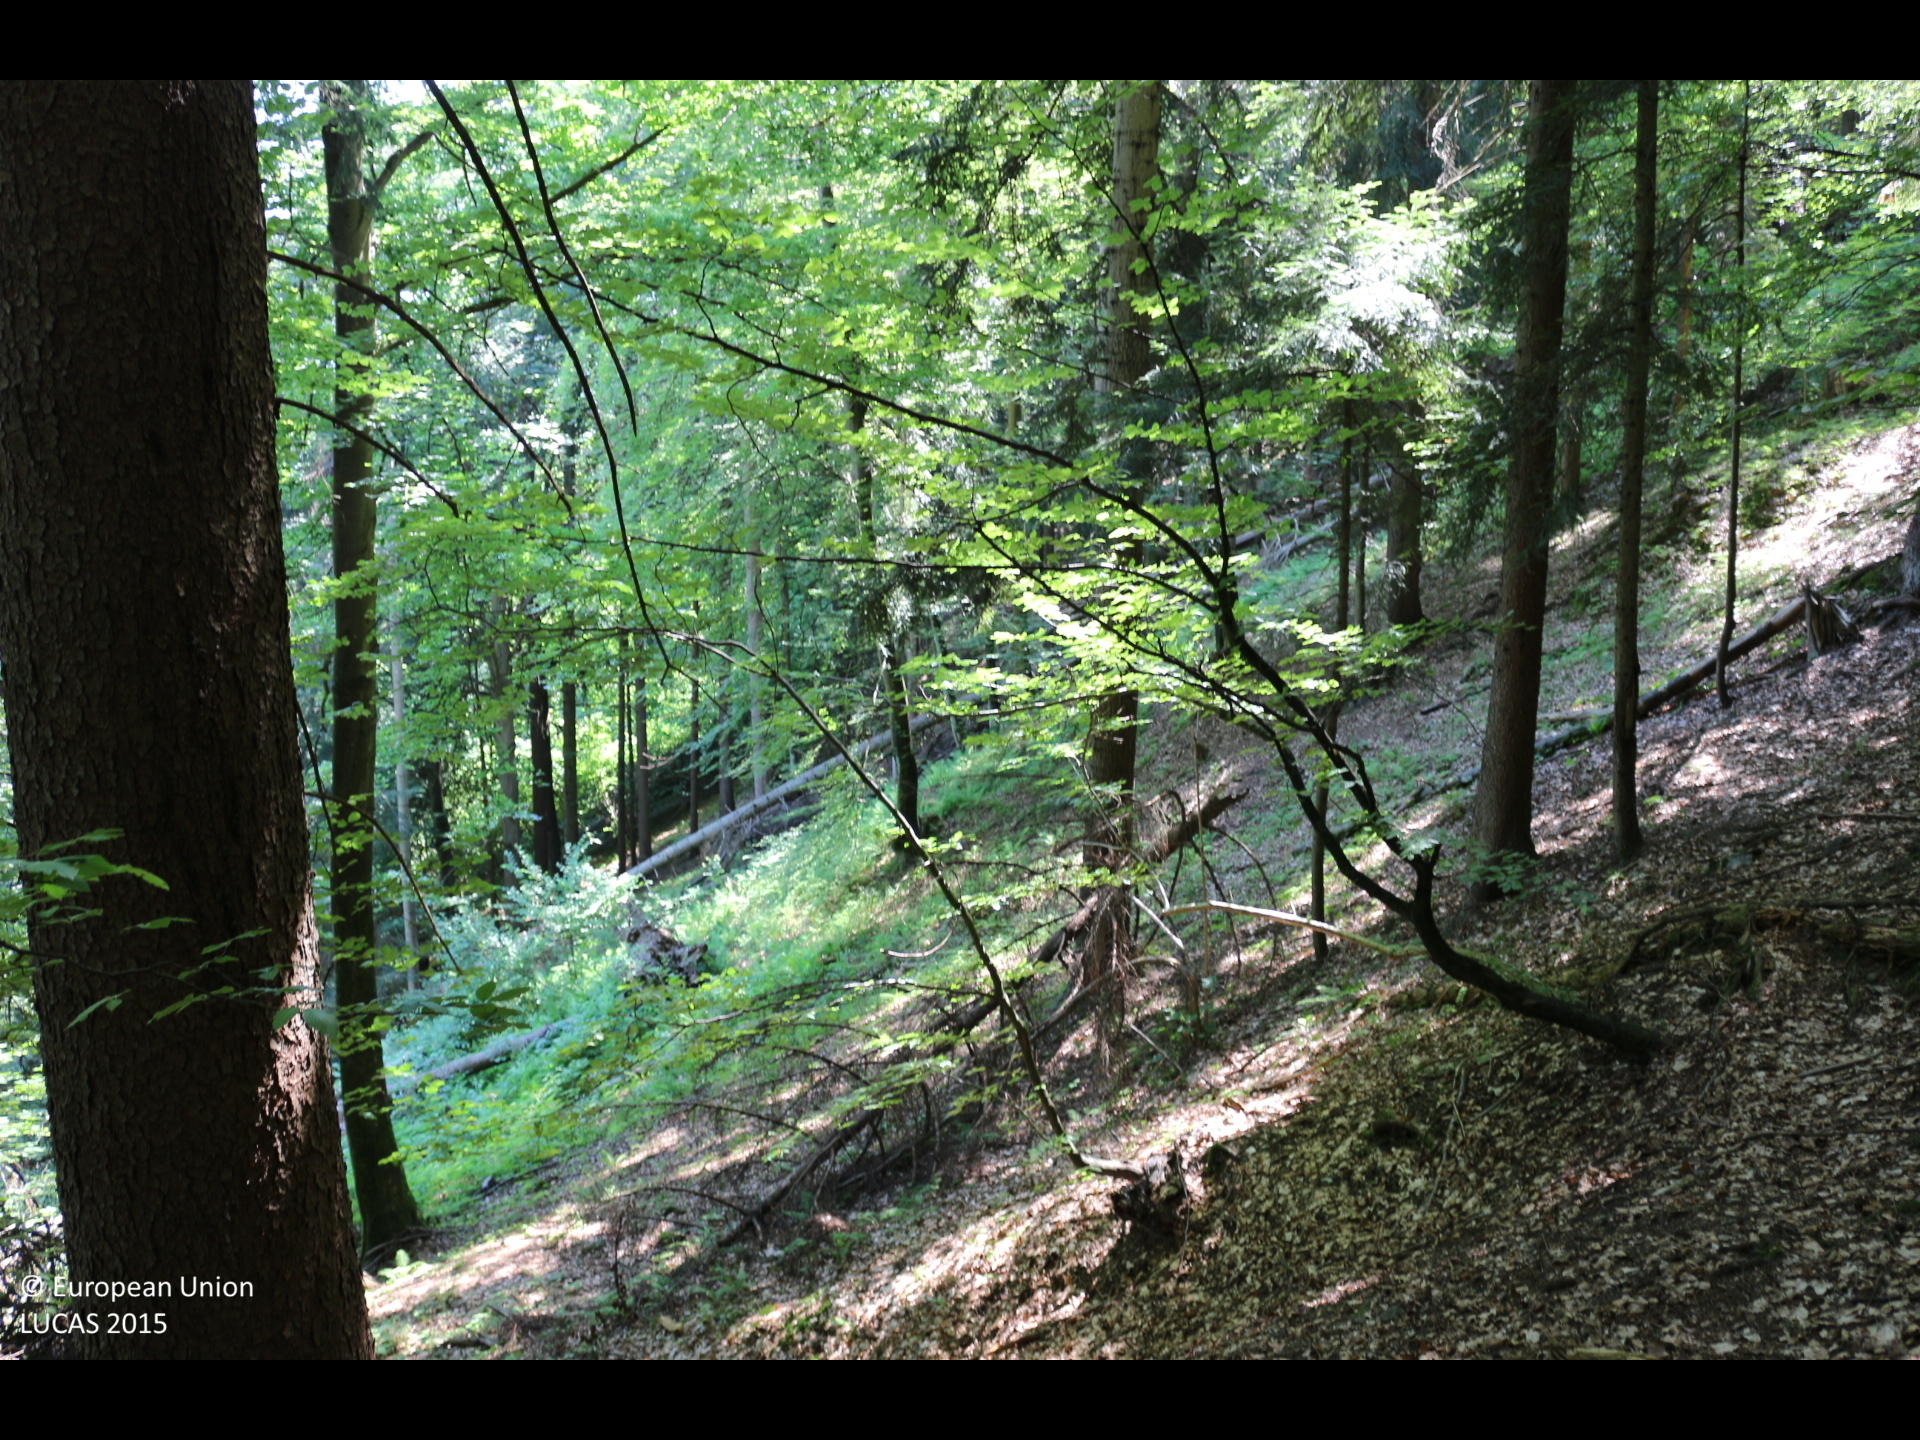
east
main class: Woodland
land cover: Other mixed woodland
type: mountainous beech forest
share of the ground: > 75 %
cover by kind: broadleaved forest trees 60 %, coniferous forest trees 40 %
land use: Forestry
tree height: > 5 m
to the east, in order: Other mixed woodland; Spruce dominated mixed woodland; Ditches and canals; Spruce dominated mixed woodland; Rivers and streams; Spruce dominated mixed woodland; Broadleaved woodland; Spontaneously vegetated surfaces; Spruce dominated mixed woodland
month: July
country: AT
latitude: 46.5804
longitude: 13.5596
